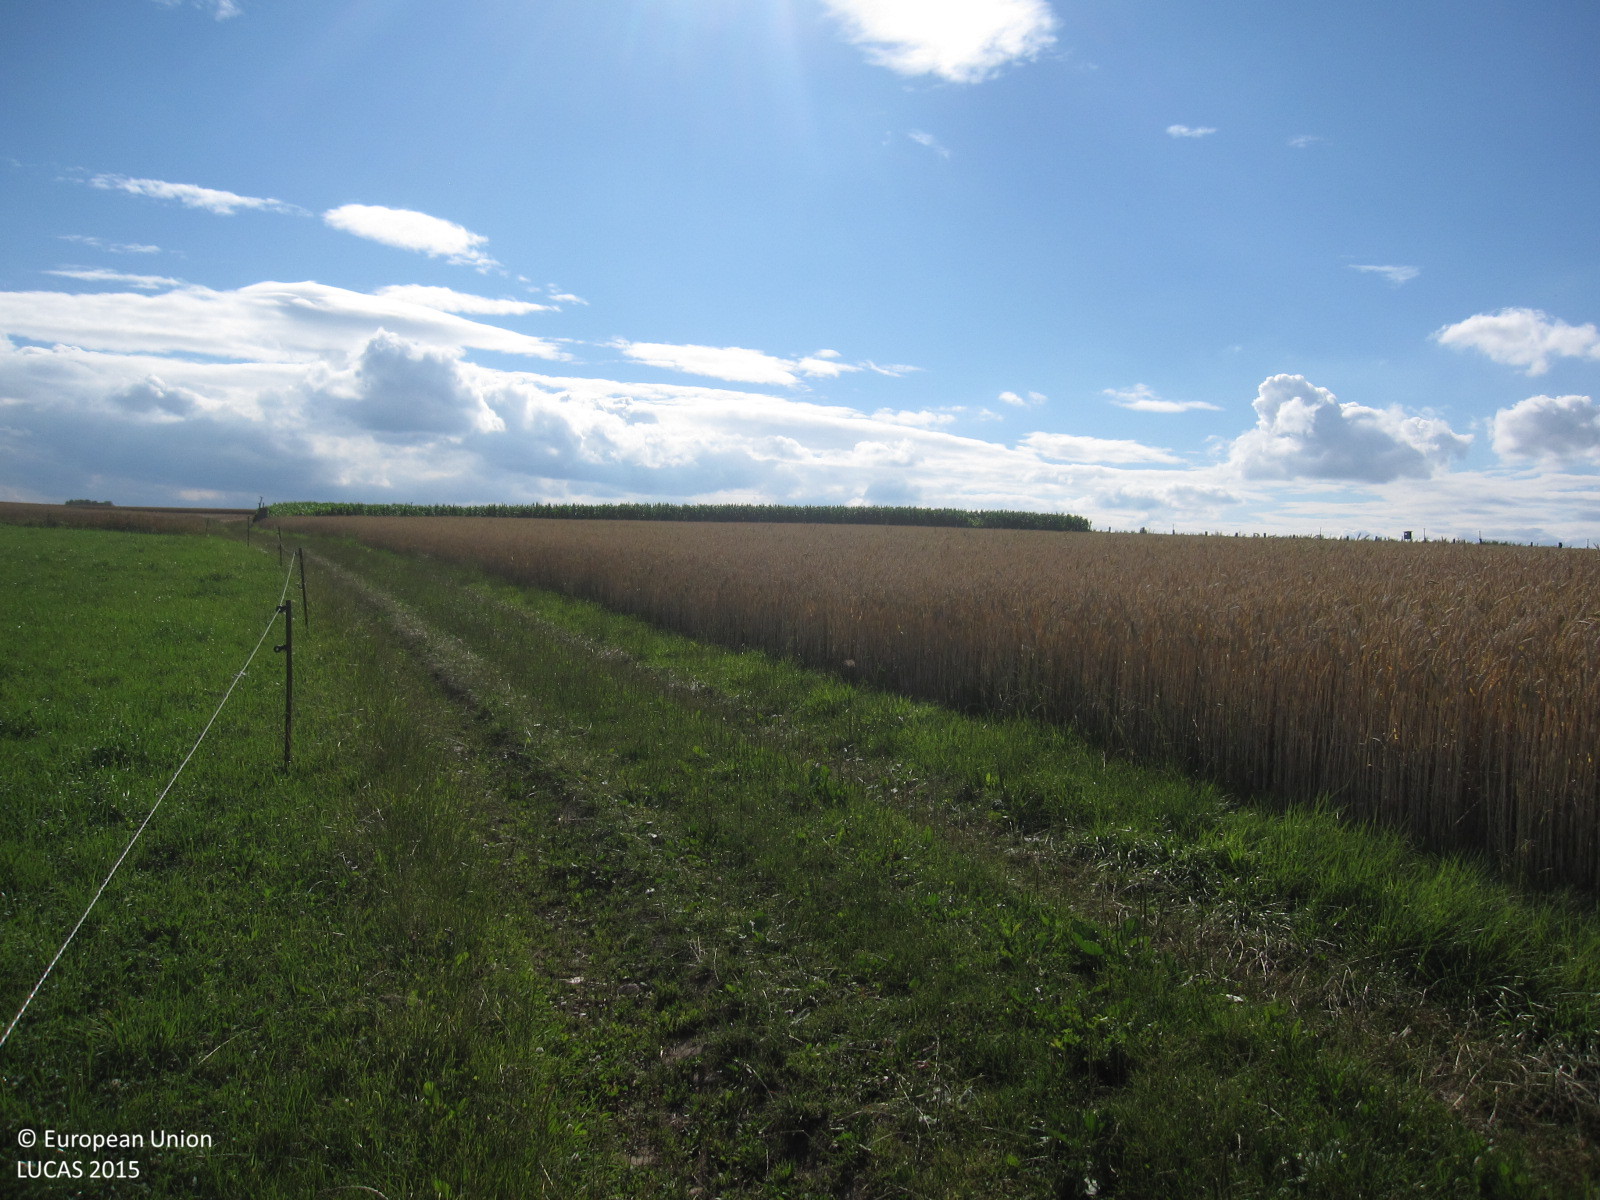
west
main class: Cropland
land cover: Common wheat
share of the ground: > 75 %
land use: Agriculture (excluding fallow land and kitchen gardens)
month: July
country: DE
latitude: 50.9570
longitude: 12.0640
